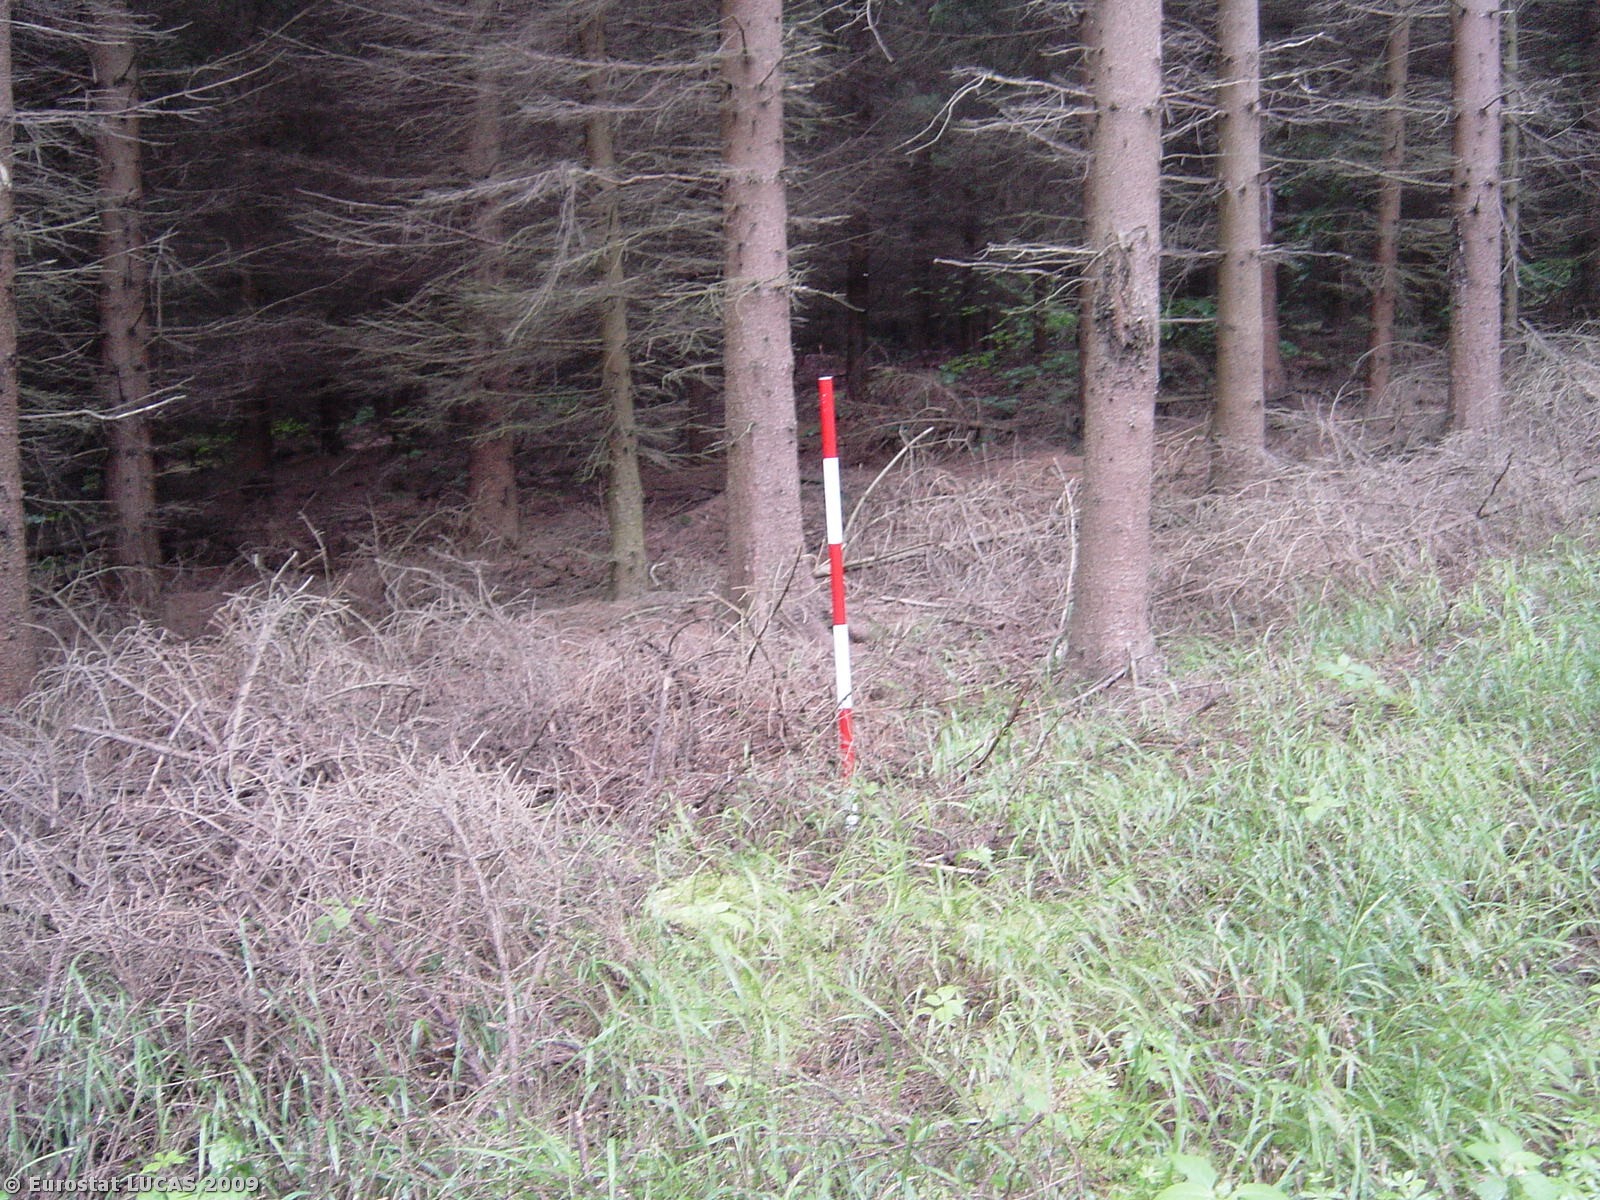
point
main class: Woodland
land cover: Coniferous woodland
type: hemiboreal forest and nemoral coniferous forest and mixed broadleaved-coniferous forest
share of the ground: > 75 %
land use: Forestry
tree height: > 5 m
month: June
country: CZ
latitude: 49.2382
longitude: 17.1381
